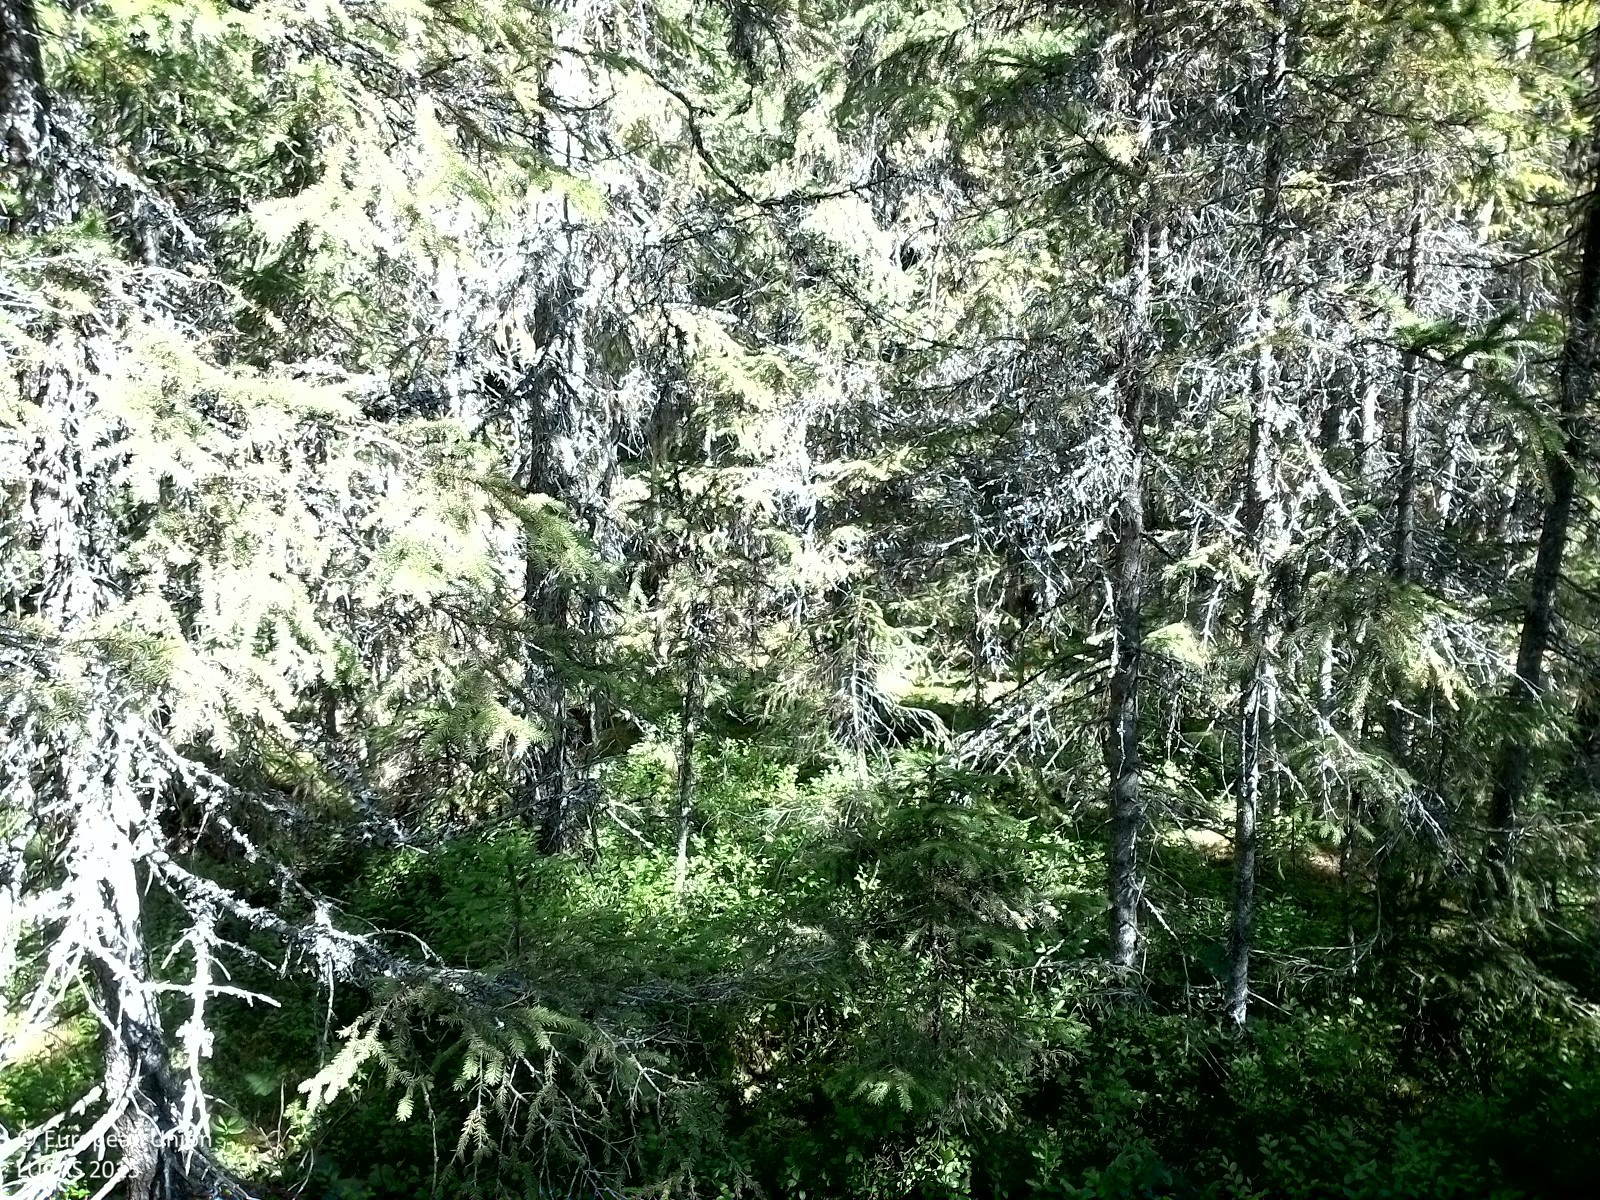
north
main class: Woodland
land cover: Spruce dominated coniferous woodland
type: boreal forest
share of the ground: 50 - 75 %
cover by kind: coniferous forest trees 45 %, shrubs 25 %, lichens and mosses 25 %, broadleaved forest trees 5 %
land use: Semi-natural and natural areas not in use
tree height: < 5 m
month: August
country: SE
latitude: 62.5311
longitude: 16.8000
